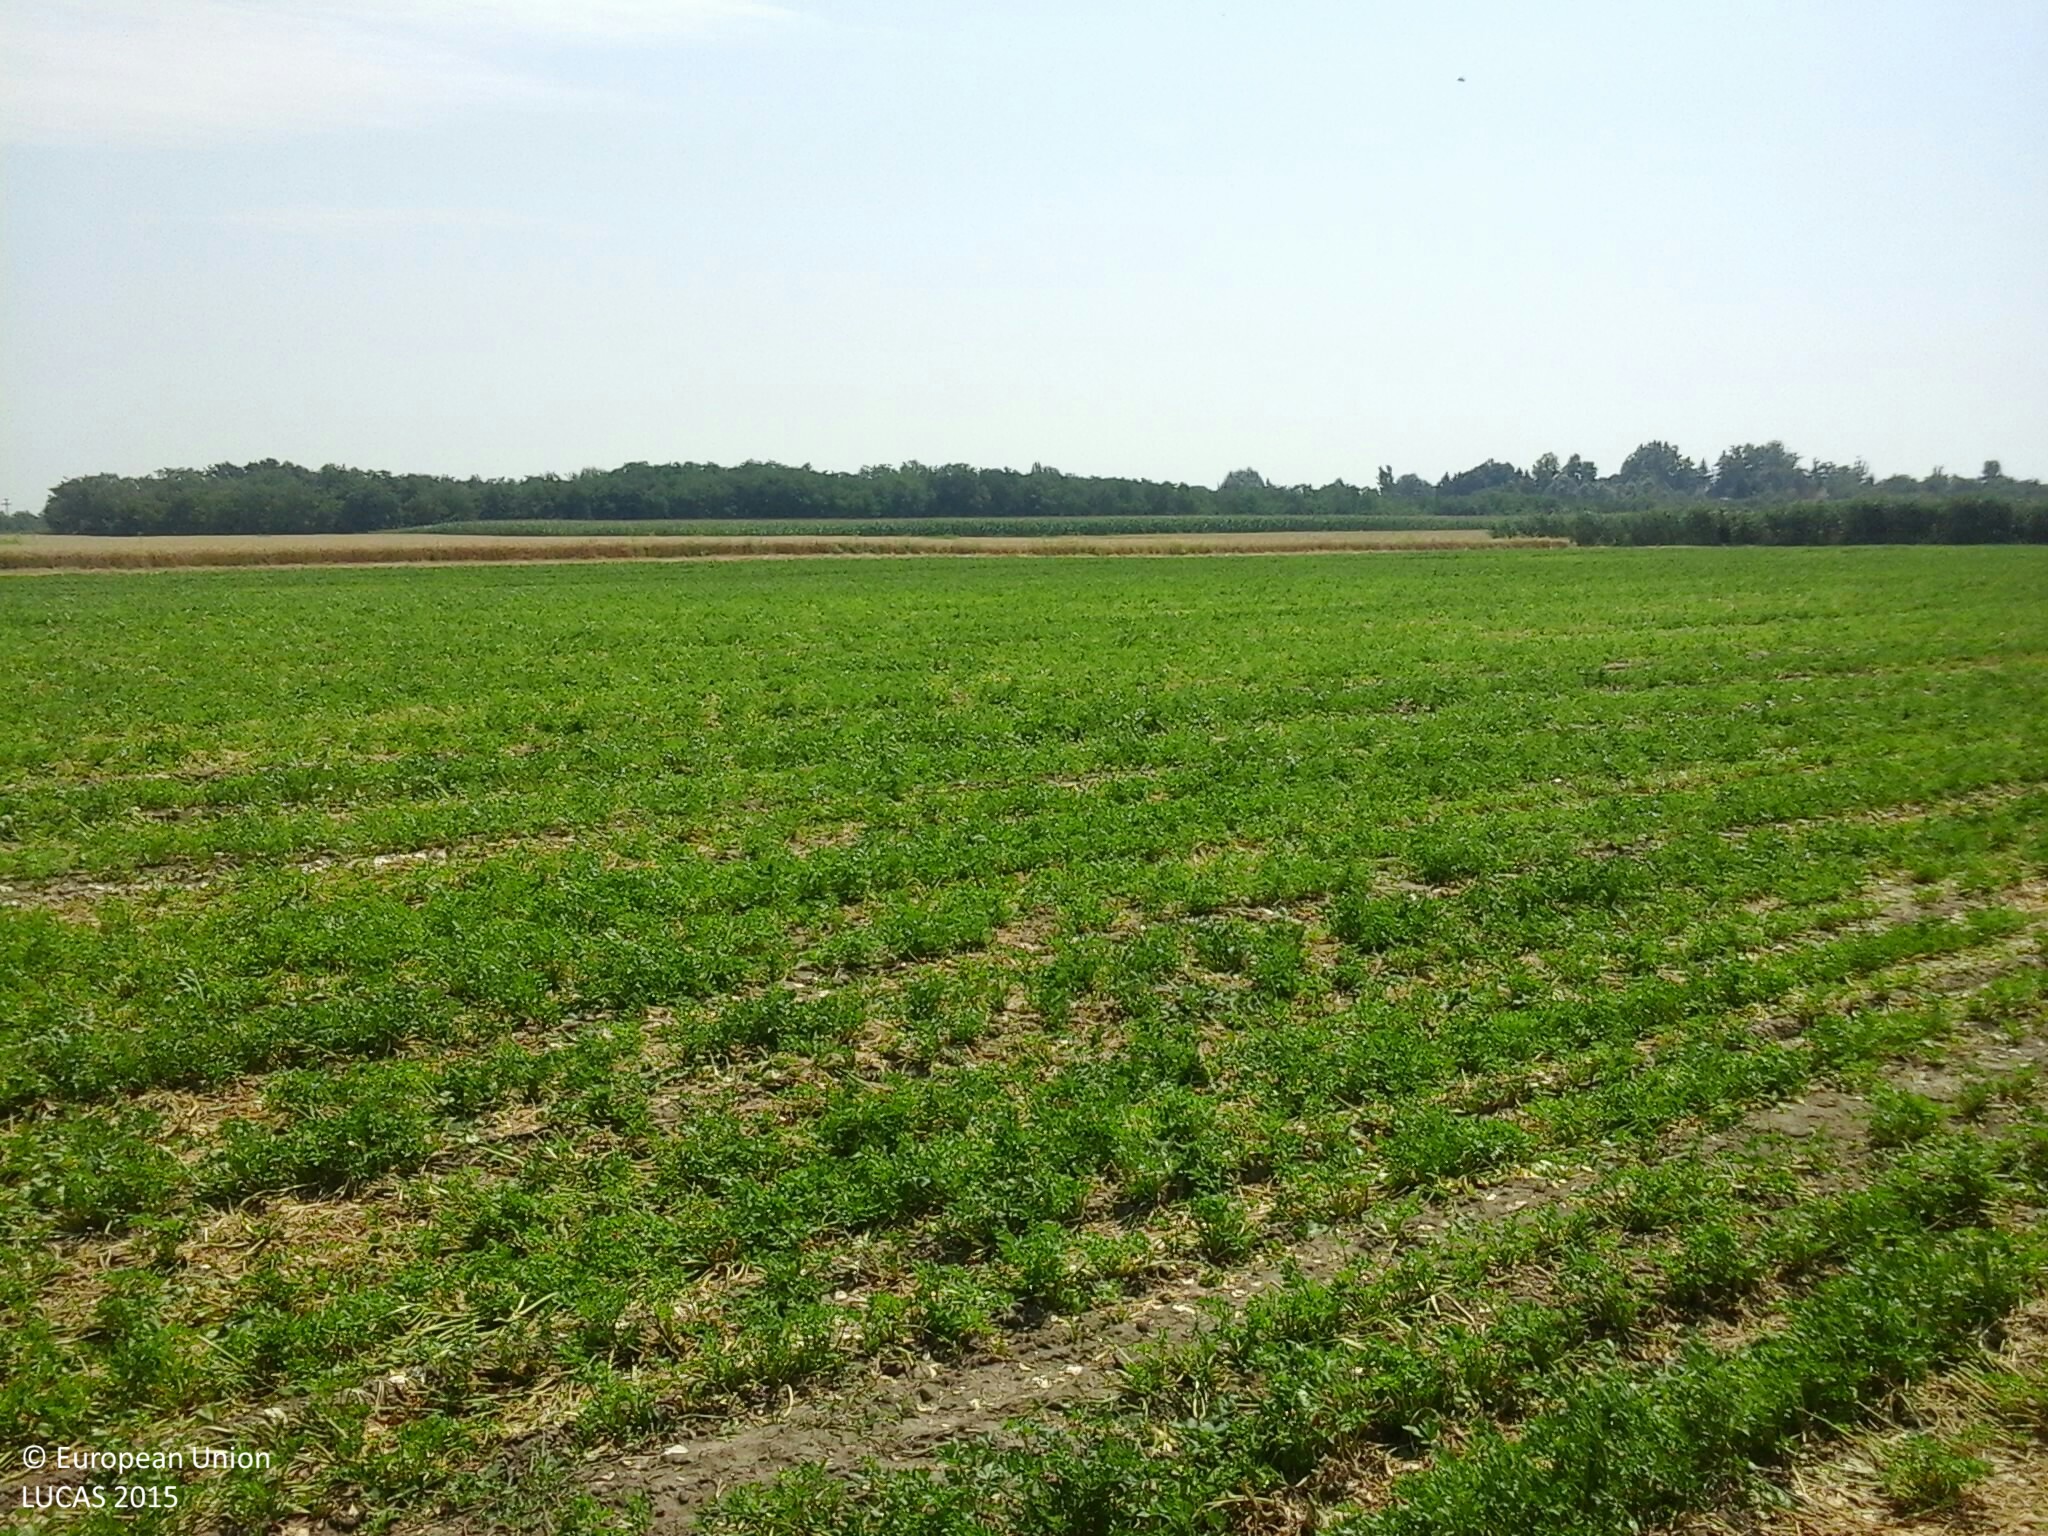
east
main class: Cropland
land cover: Other non-permanent industrial crops
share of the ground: 50 - 75 %
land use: Agriculture (excluding fallow land and kitchen gardens)
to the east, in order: Other non-permanent industrial crops; Tracks; Barley
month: July
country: HU
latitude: 46.9706
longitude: 20.1858
